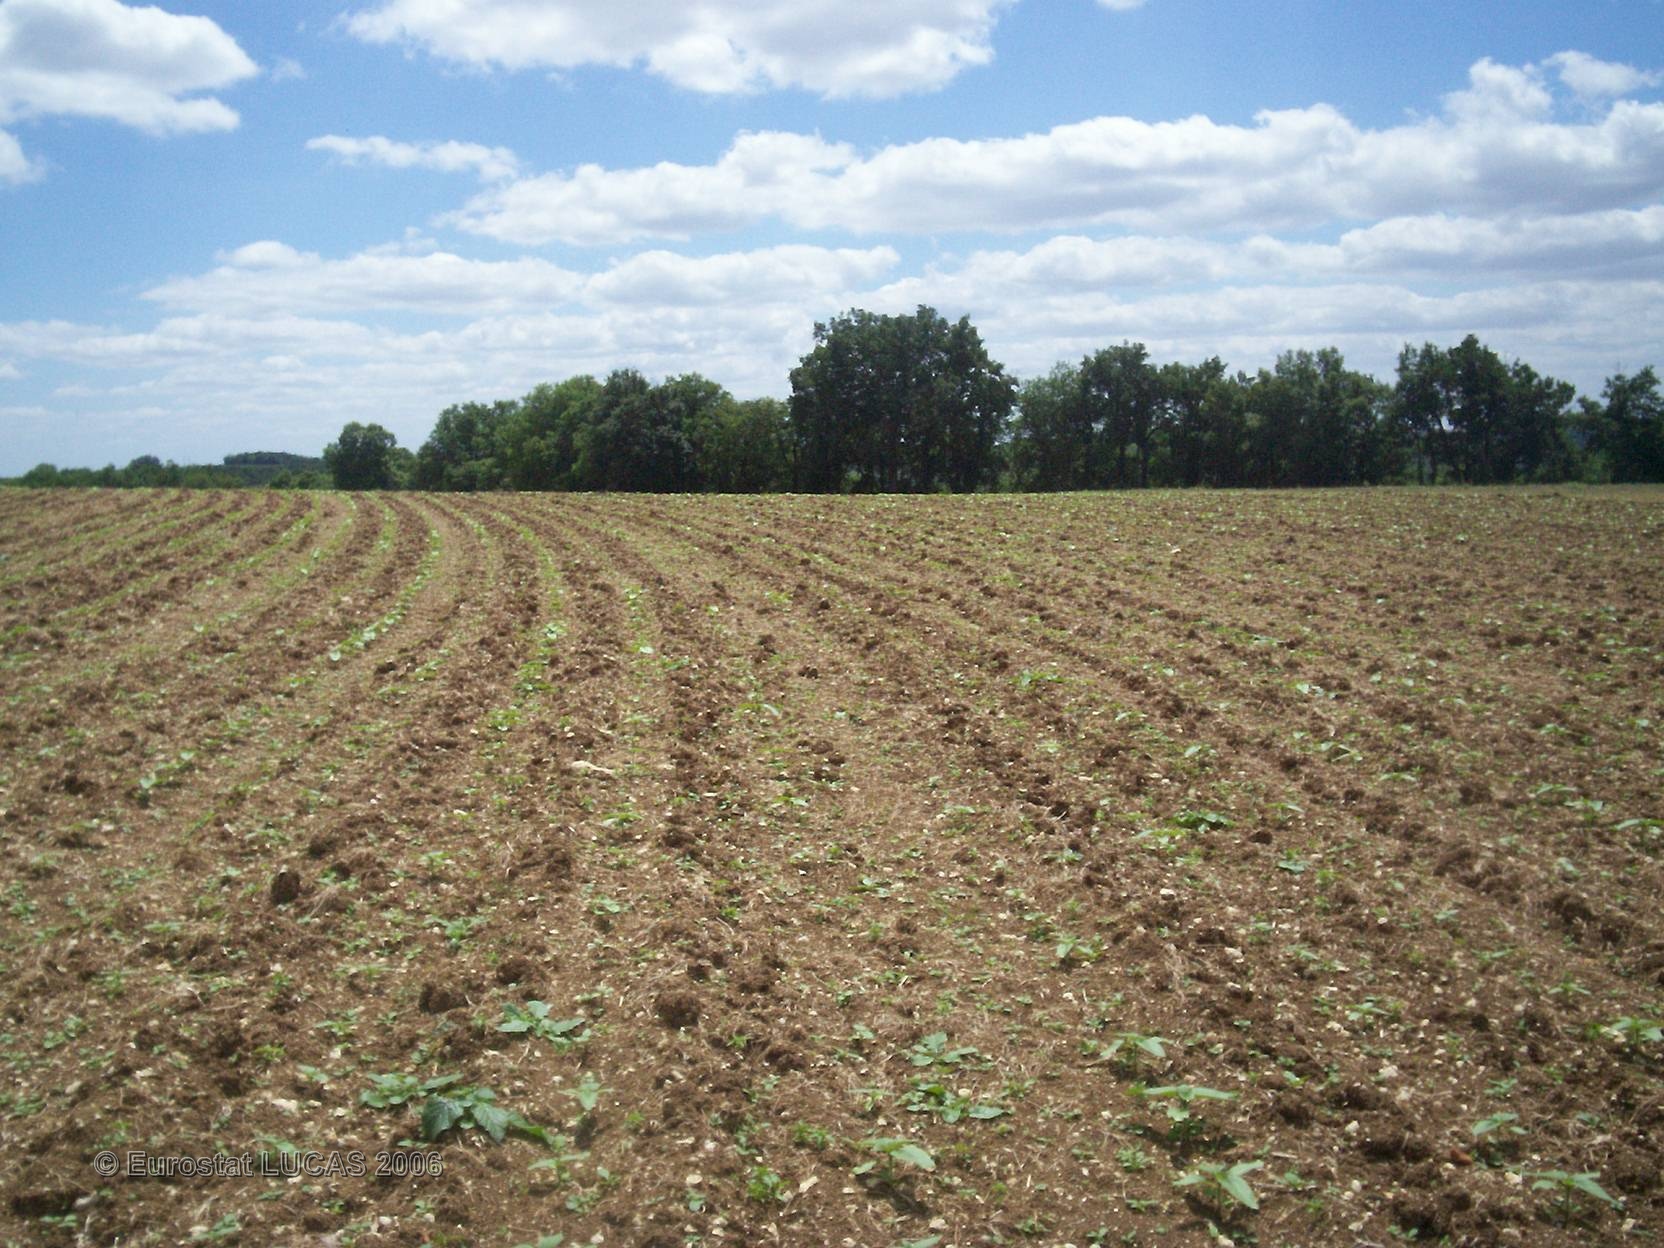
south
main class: Cropland
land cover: Sunflower
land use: Agriculture (excluding fallow land and kitchen gardens)
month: May
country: FR
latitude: 44.2732
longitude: 0.8625
